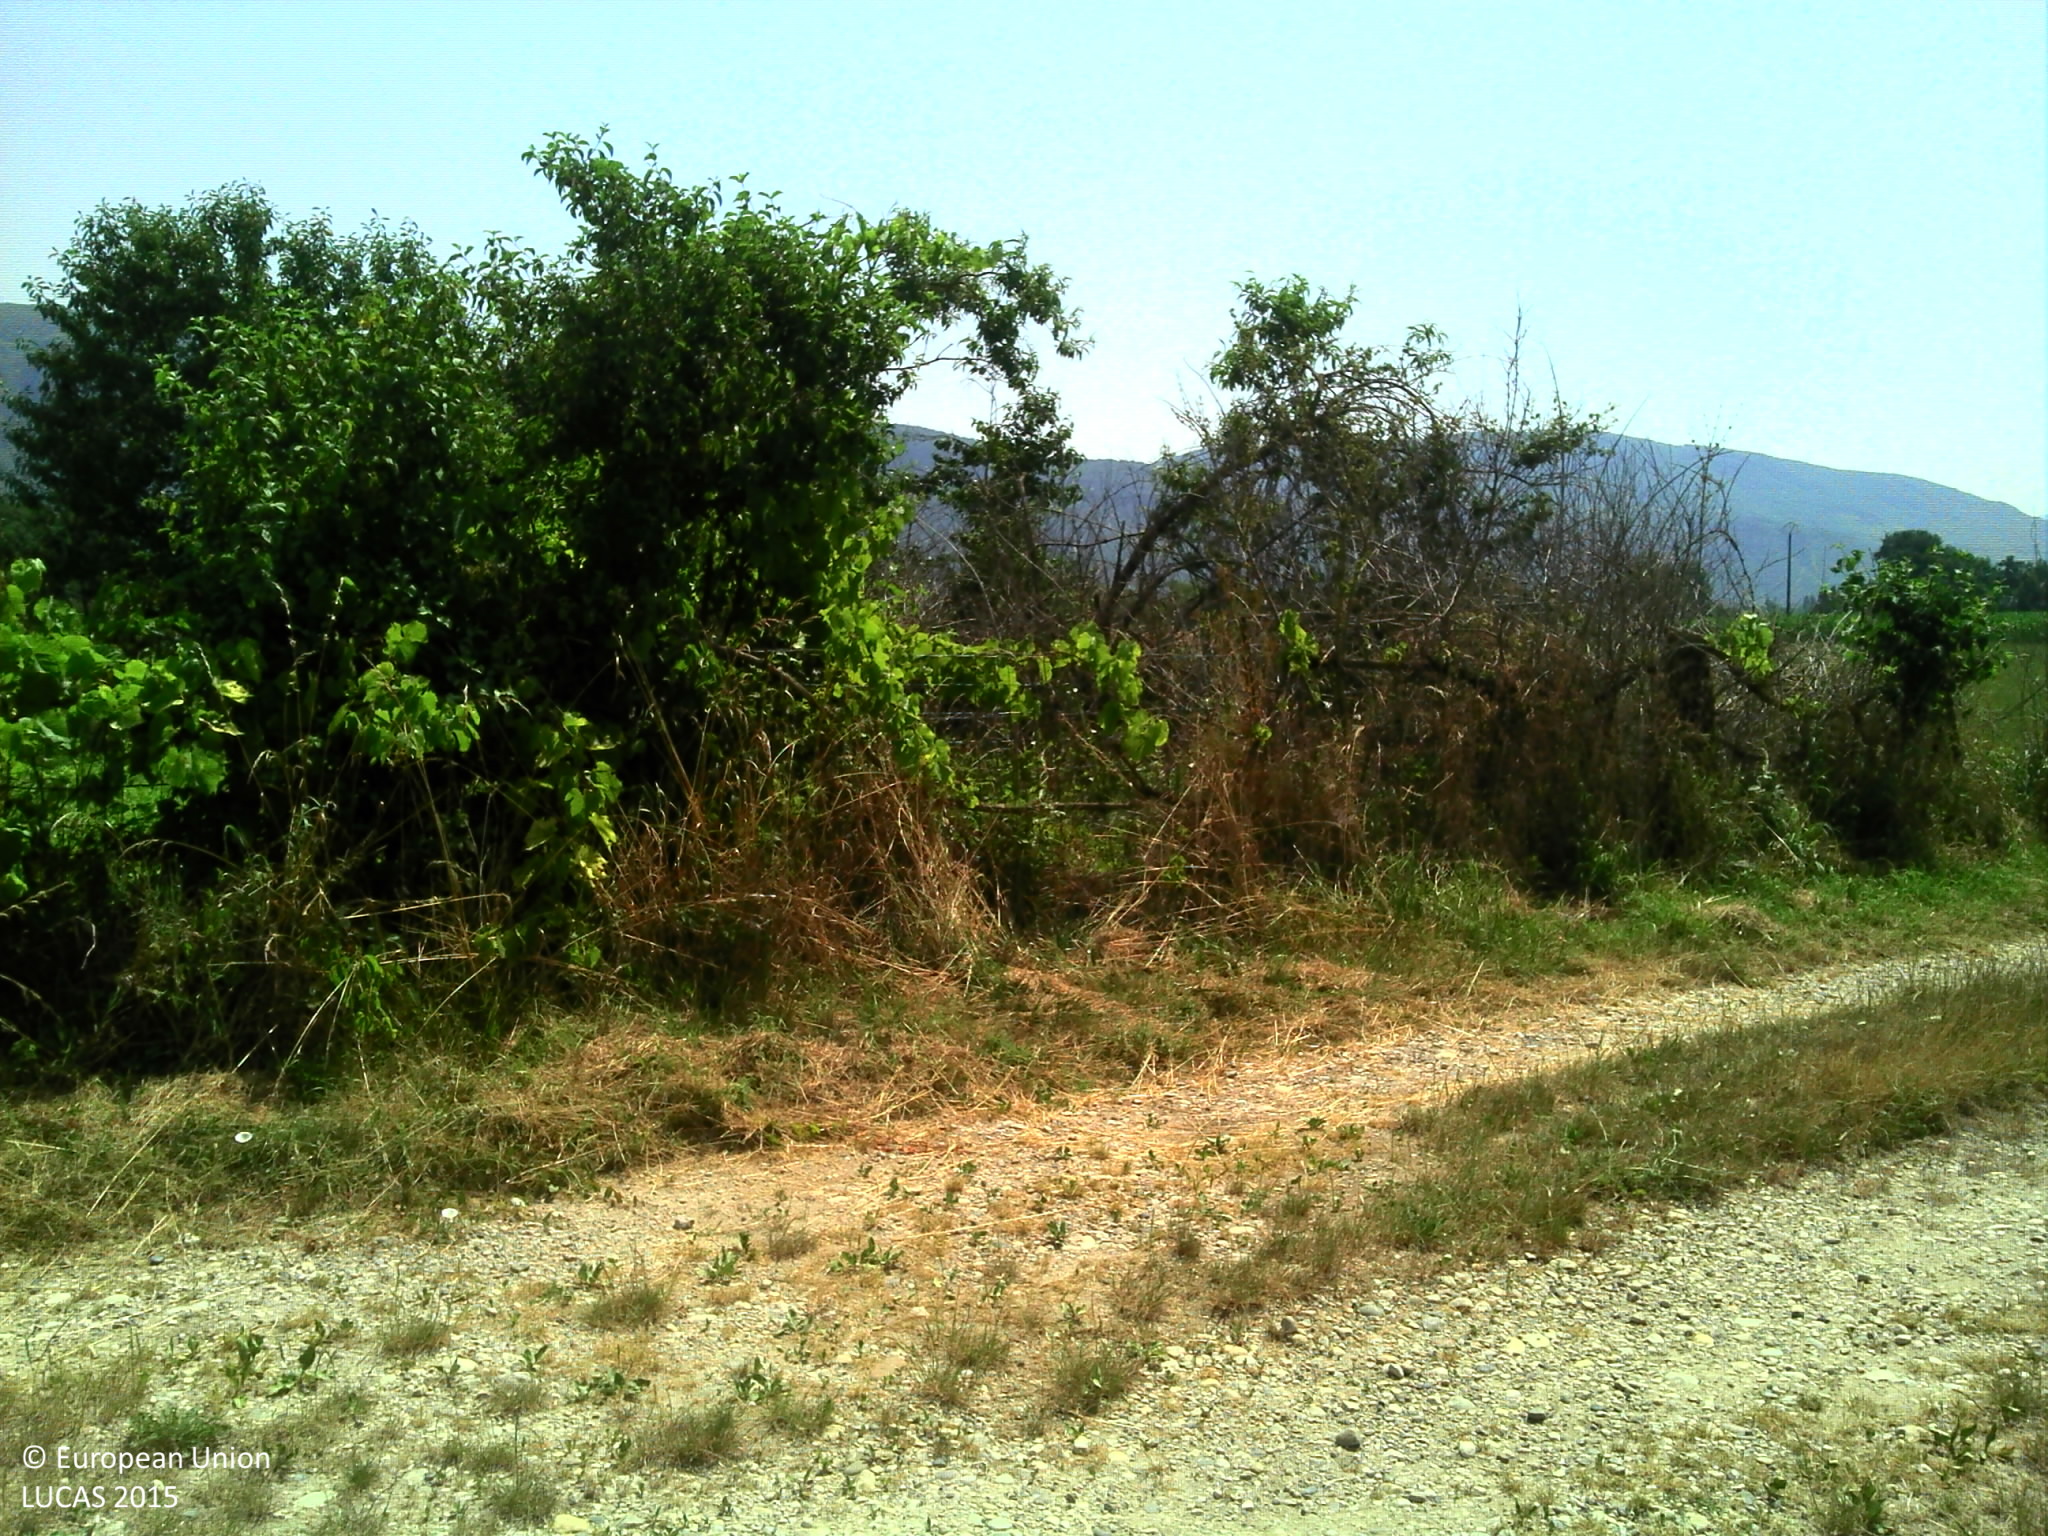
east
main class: Grassland
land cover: Grassland without tree/shrub cover
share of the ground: > 75 %
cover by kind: herbaceous plants 100 %
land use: Agriculture (excluding fallow land and kitchen gardens)
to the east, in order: Tracks; Grass margins; Fences; Managed hedges; Grassland without tree/shrub cover; Fences; Grassland without tree/shrub cover; Fences; Grassland without tree/shrub cover; Fences; Common wheat
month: July
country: FR
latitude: 45.8197
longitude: 5.4091
